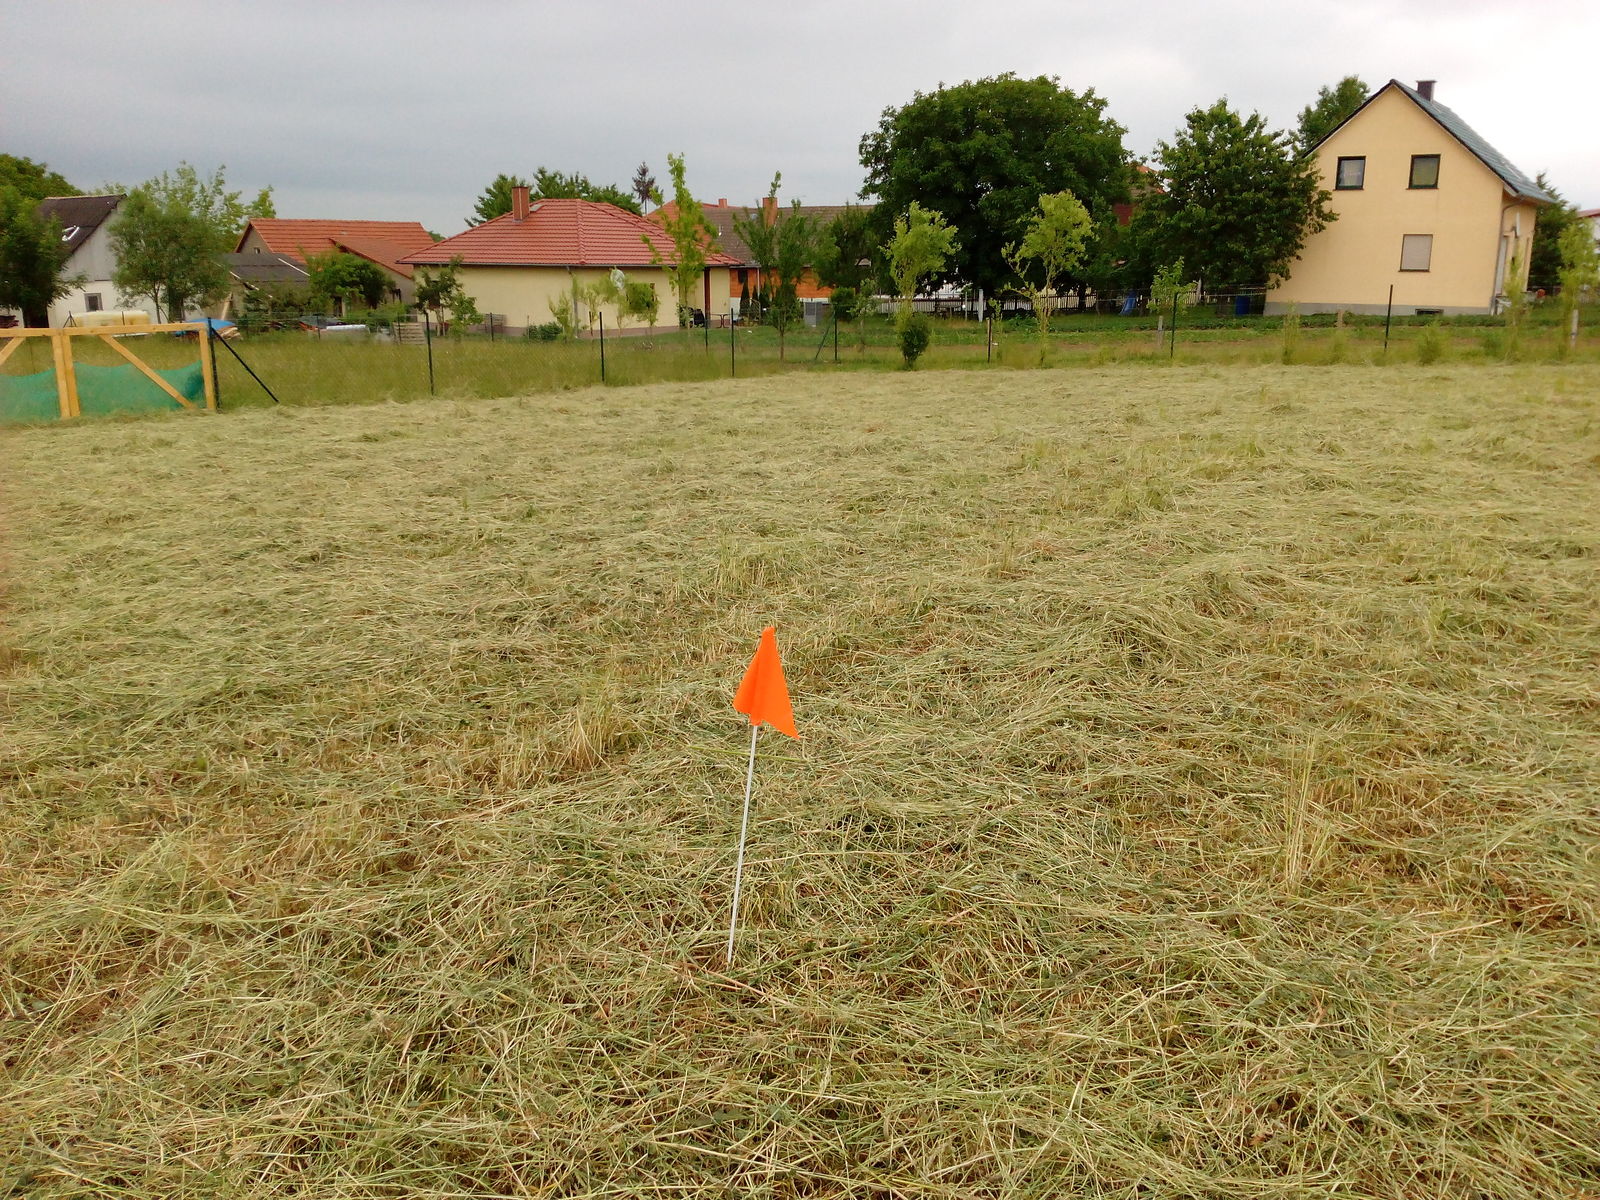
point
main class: Grassland
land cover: Grassland without tree/shrub cover
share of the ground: > 75 %
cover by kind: herbaceous plants 100 %
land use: Agriculture (excluding fallow land and kitchen gardens)
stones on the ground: < 10 %
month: June
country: DE
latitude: 51.0636
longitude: 10.6134
